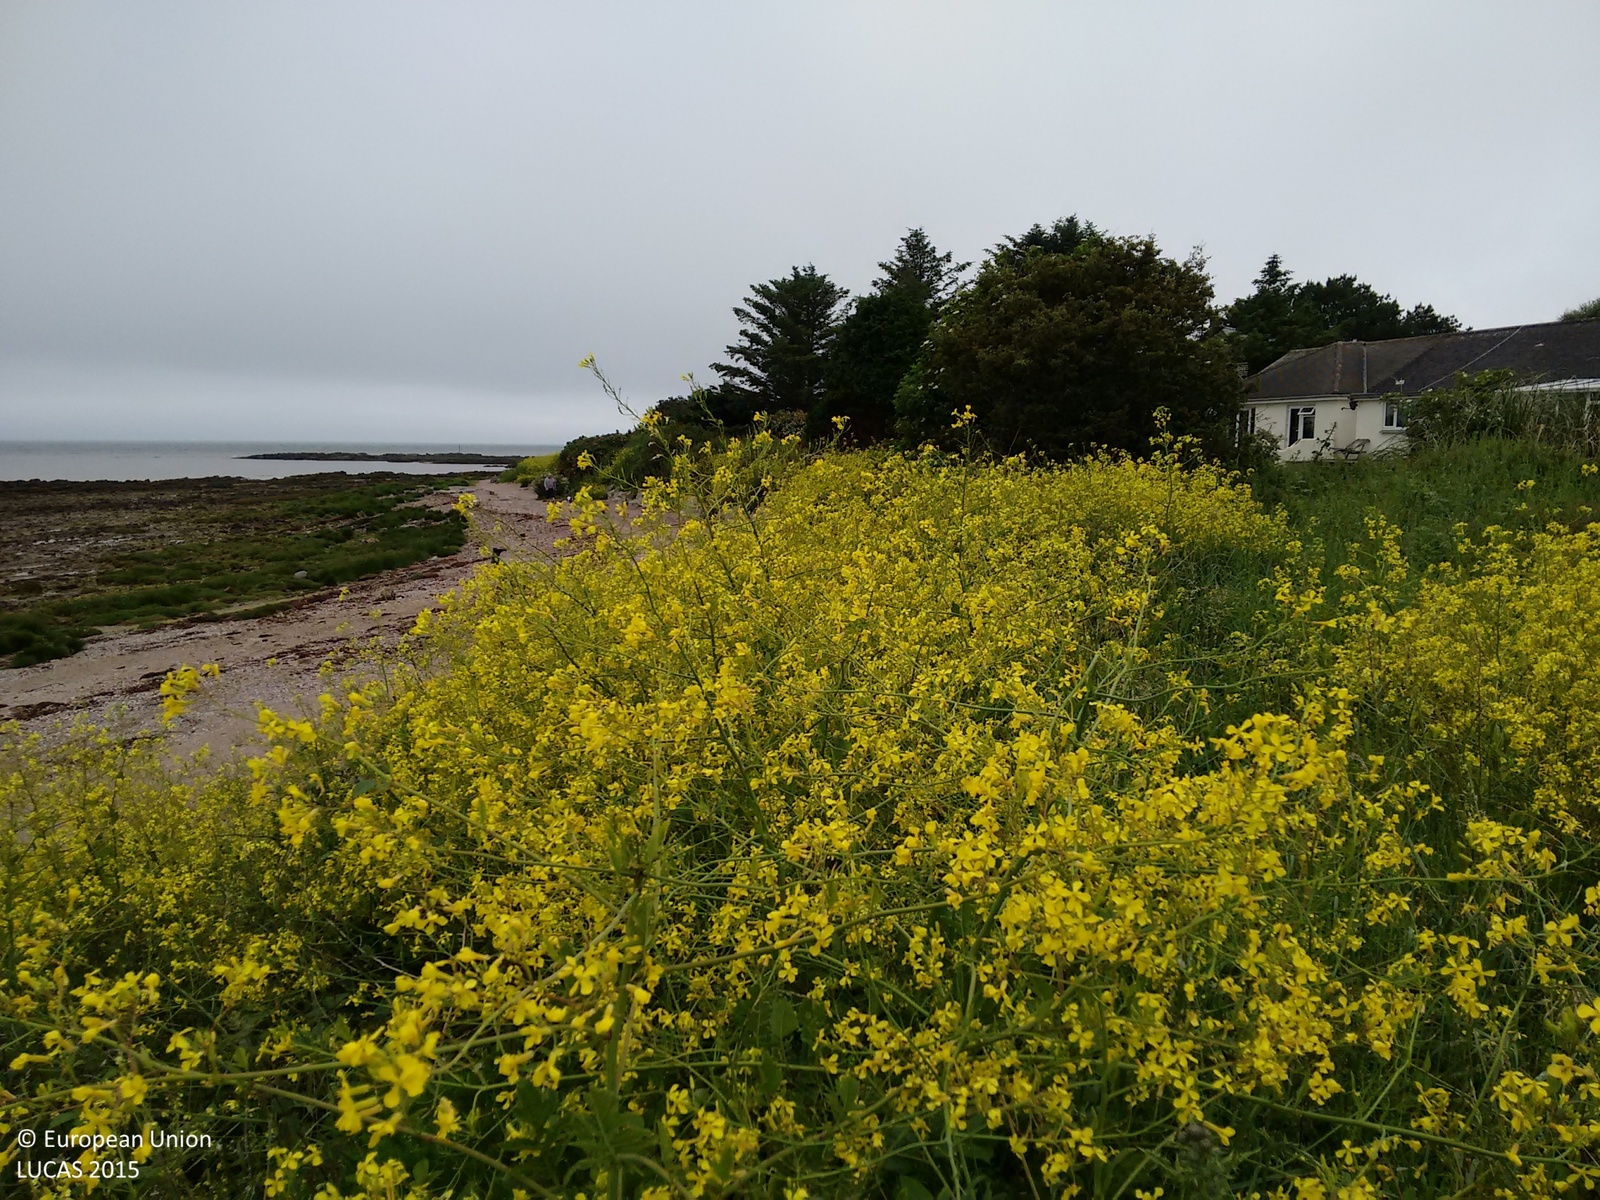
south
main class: Grassland
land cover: Grassland without tree/shrub cover
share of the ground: > 75 %
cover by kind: herbaceous plants 100 %
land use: Residential
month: July
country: GB
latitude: 54.8754
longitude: -3.5947
